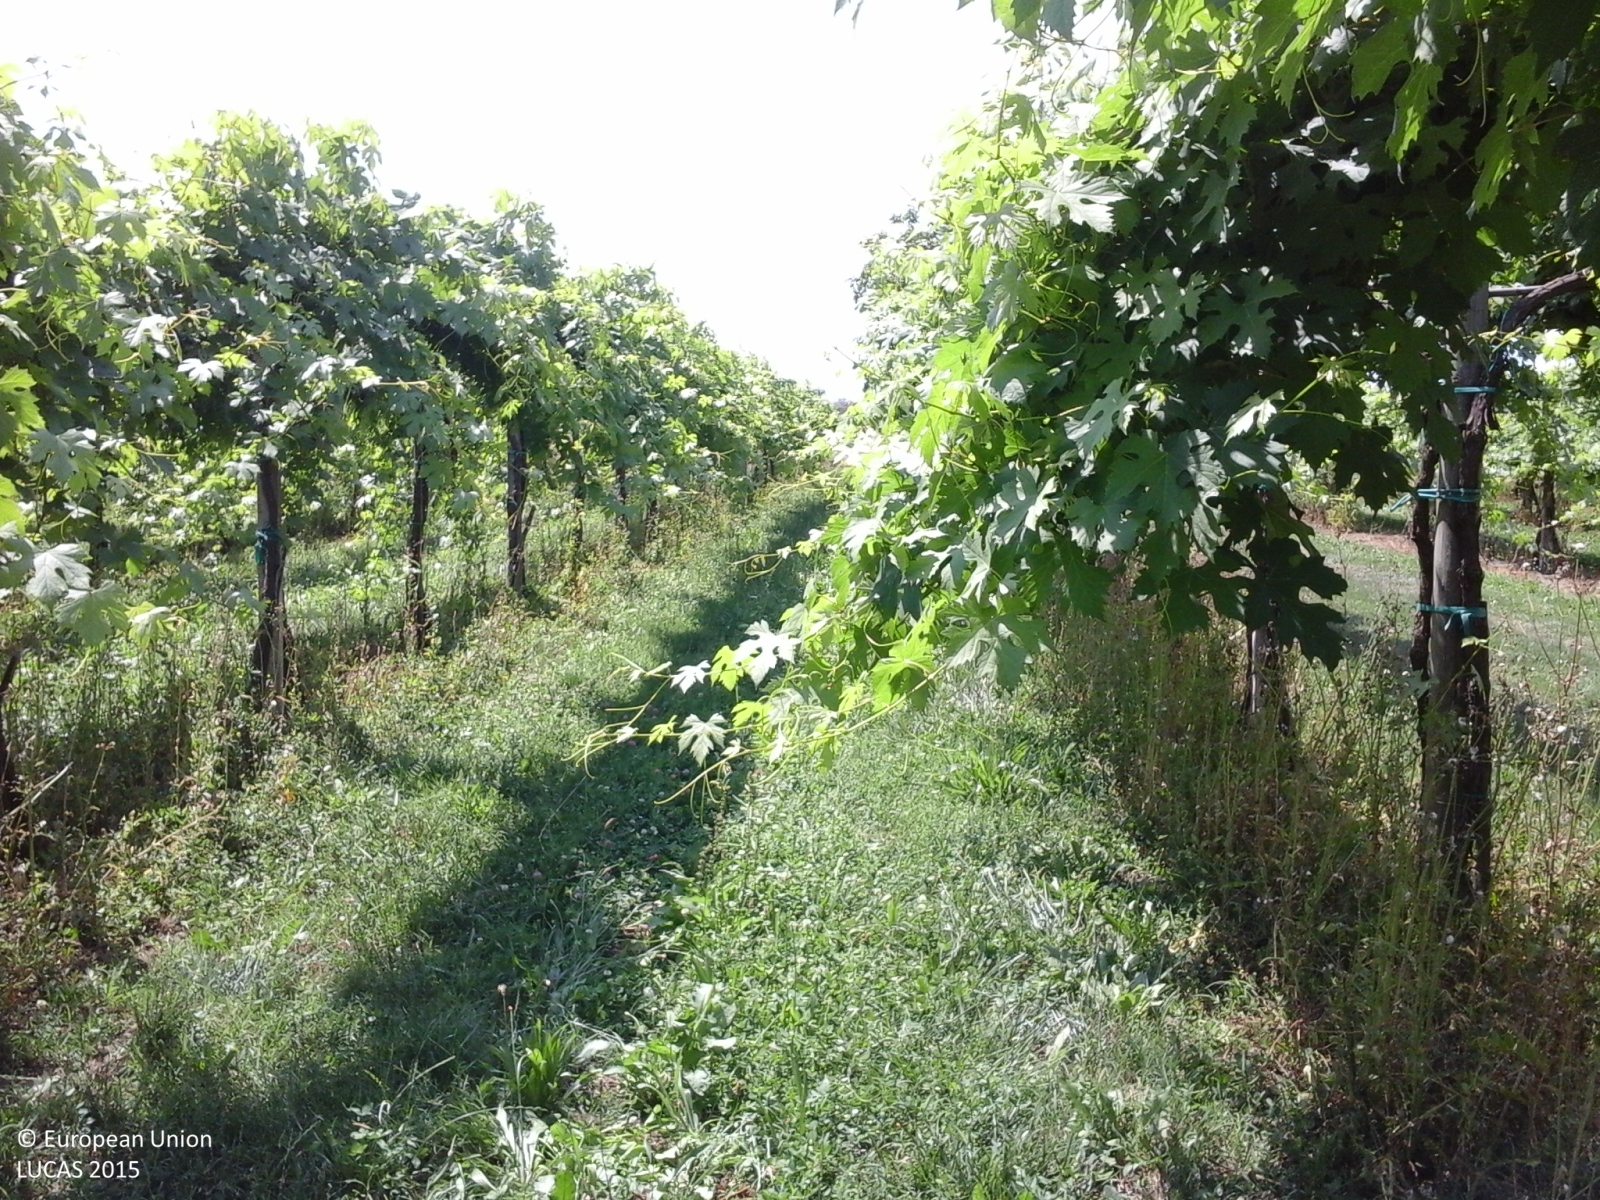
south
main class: Cropland
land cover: Vineyards
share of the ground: 50 - 75 %
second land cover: Grassland without tree/shrub cover
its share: > 75 %
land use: Agriculture (excluding fallow land and kitchen gardens)
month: June
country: IT
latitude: 44.6907
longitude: 10.7177
